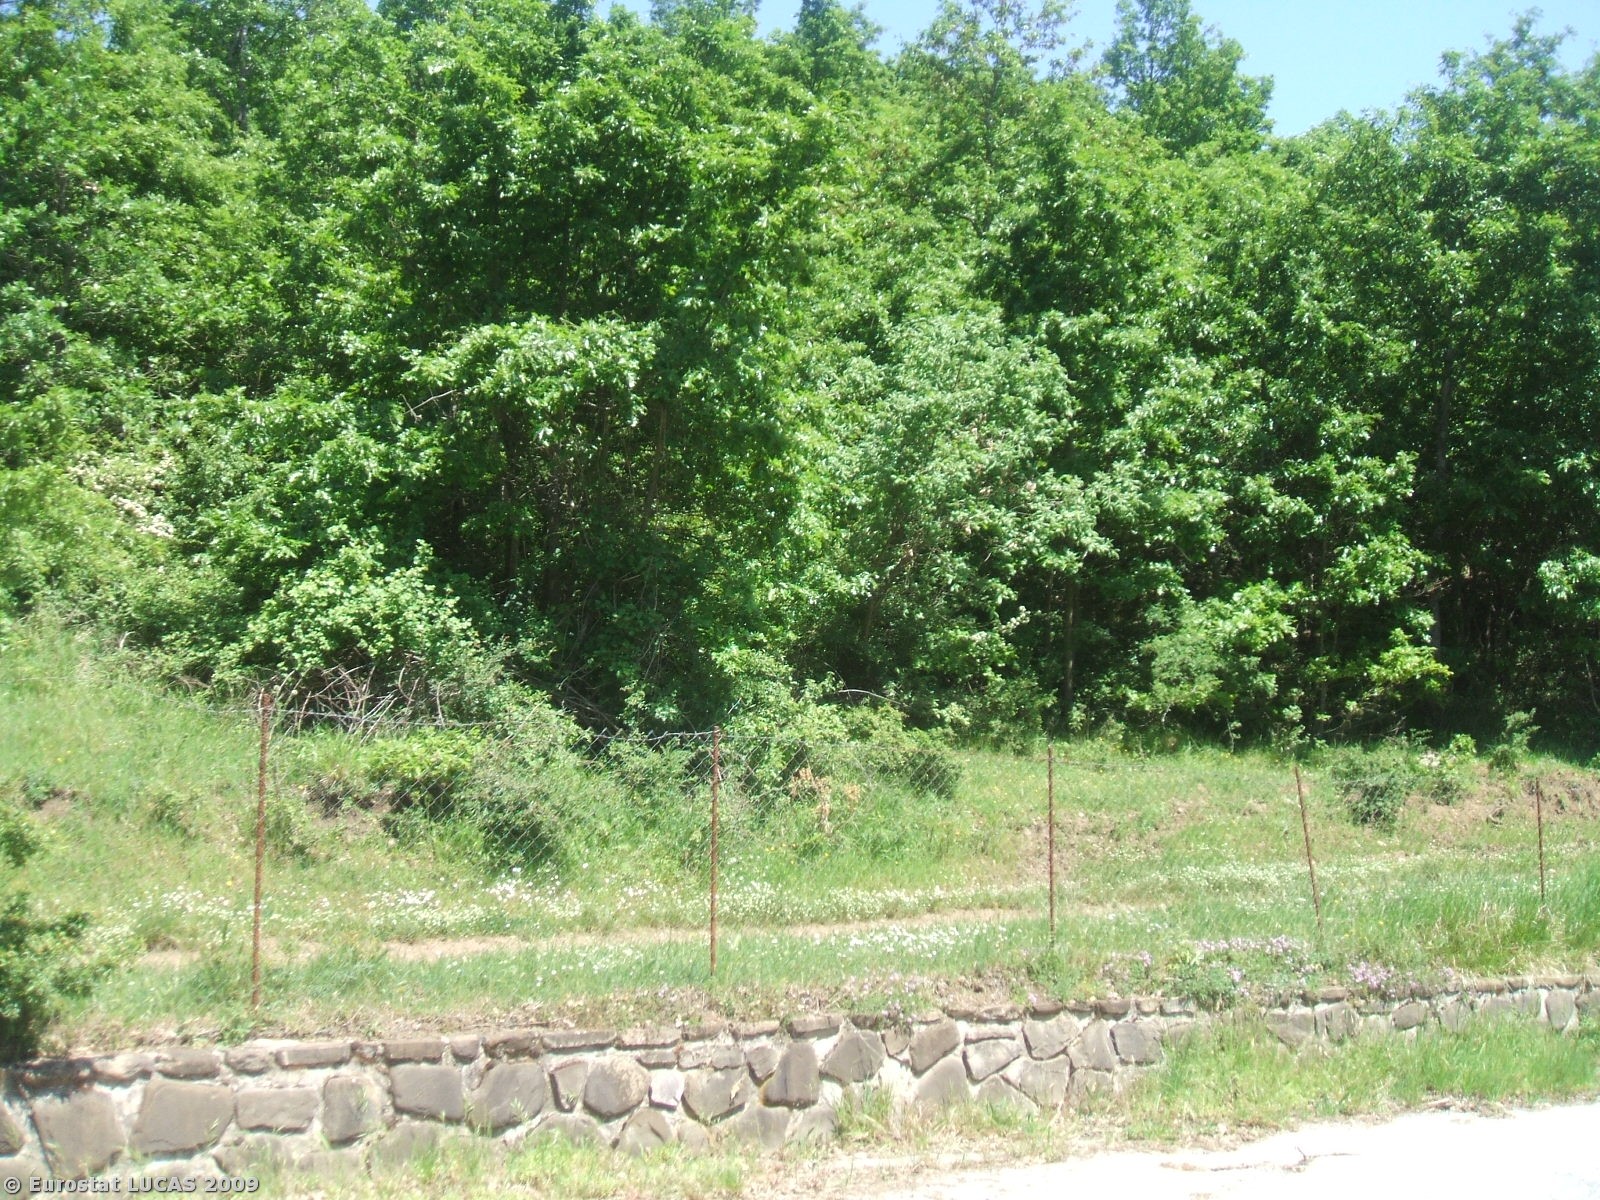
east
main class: Woodland
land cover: Broadleaved woodland
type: thermophilous deciduous forest
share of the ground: > 75 %
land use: Forestry
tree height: > 5 m
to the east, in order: Broadleaved woodland; Grassland with sparse tree/shrub cover; Broadleaved woodland; Grass margins; Fences; Grass margins; Paved roads, cycling and walking lanes; Grass margins; Fences; Grass margins; Broadleaved woodland; Grassland with sparse tree/shrub cover; Broadleaved woodland
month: May
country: IT
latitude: 40.3633
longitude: 15.8758
